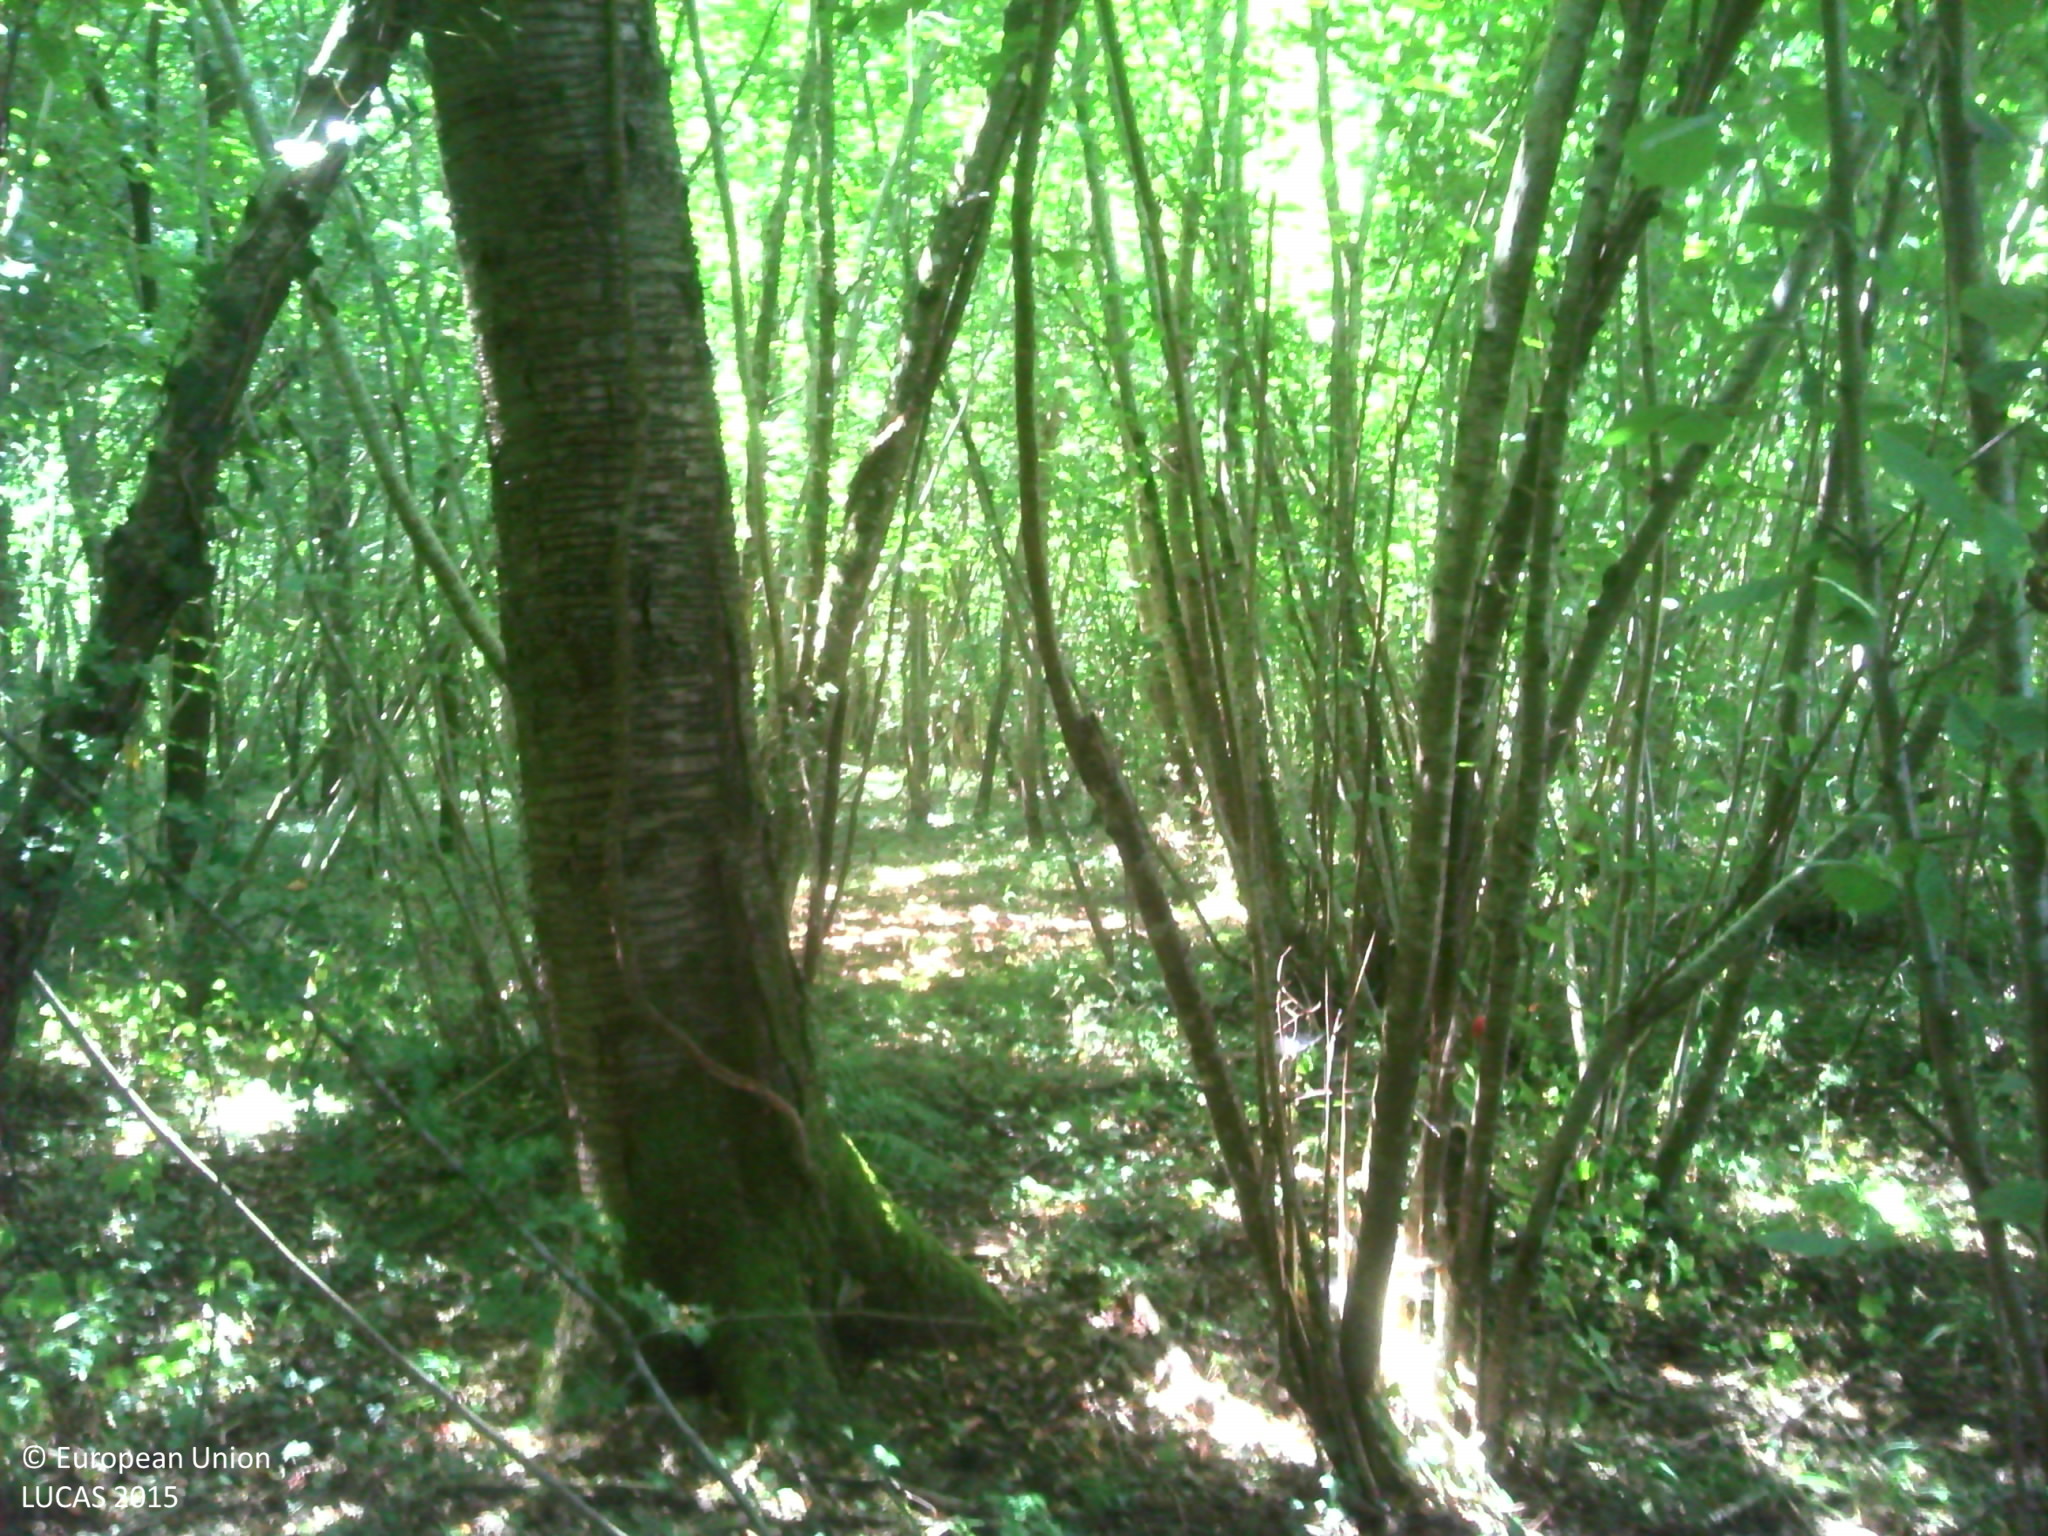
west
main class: Woodland
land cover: Broadleaved woodland
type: mesophytic deciduous forest
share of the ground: > 75 %
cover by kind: broadleaved forest trees 65 %, herbaceous plants 35 %
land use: Forestry
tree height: > 5 m
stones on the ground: 10 - 25 %
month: July
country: FR
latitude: 46.7414
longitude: 5.0412
